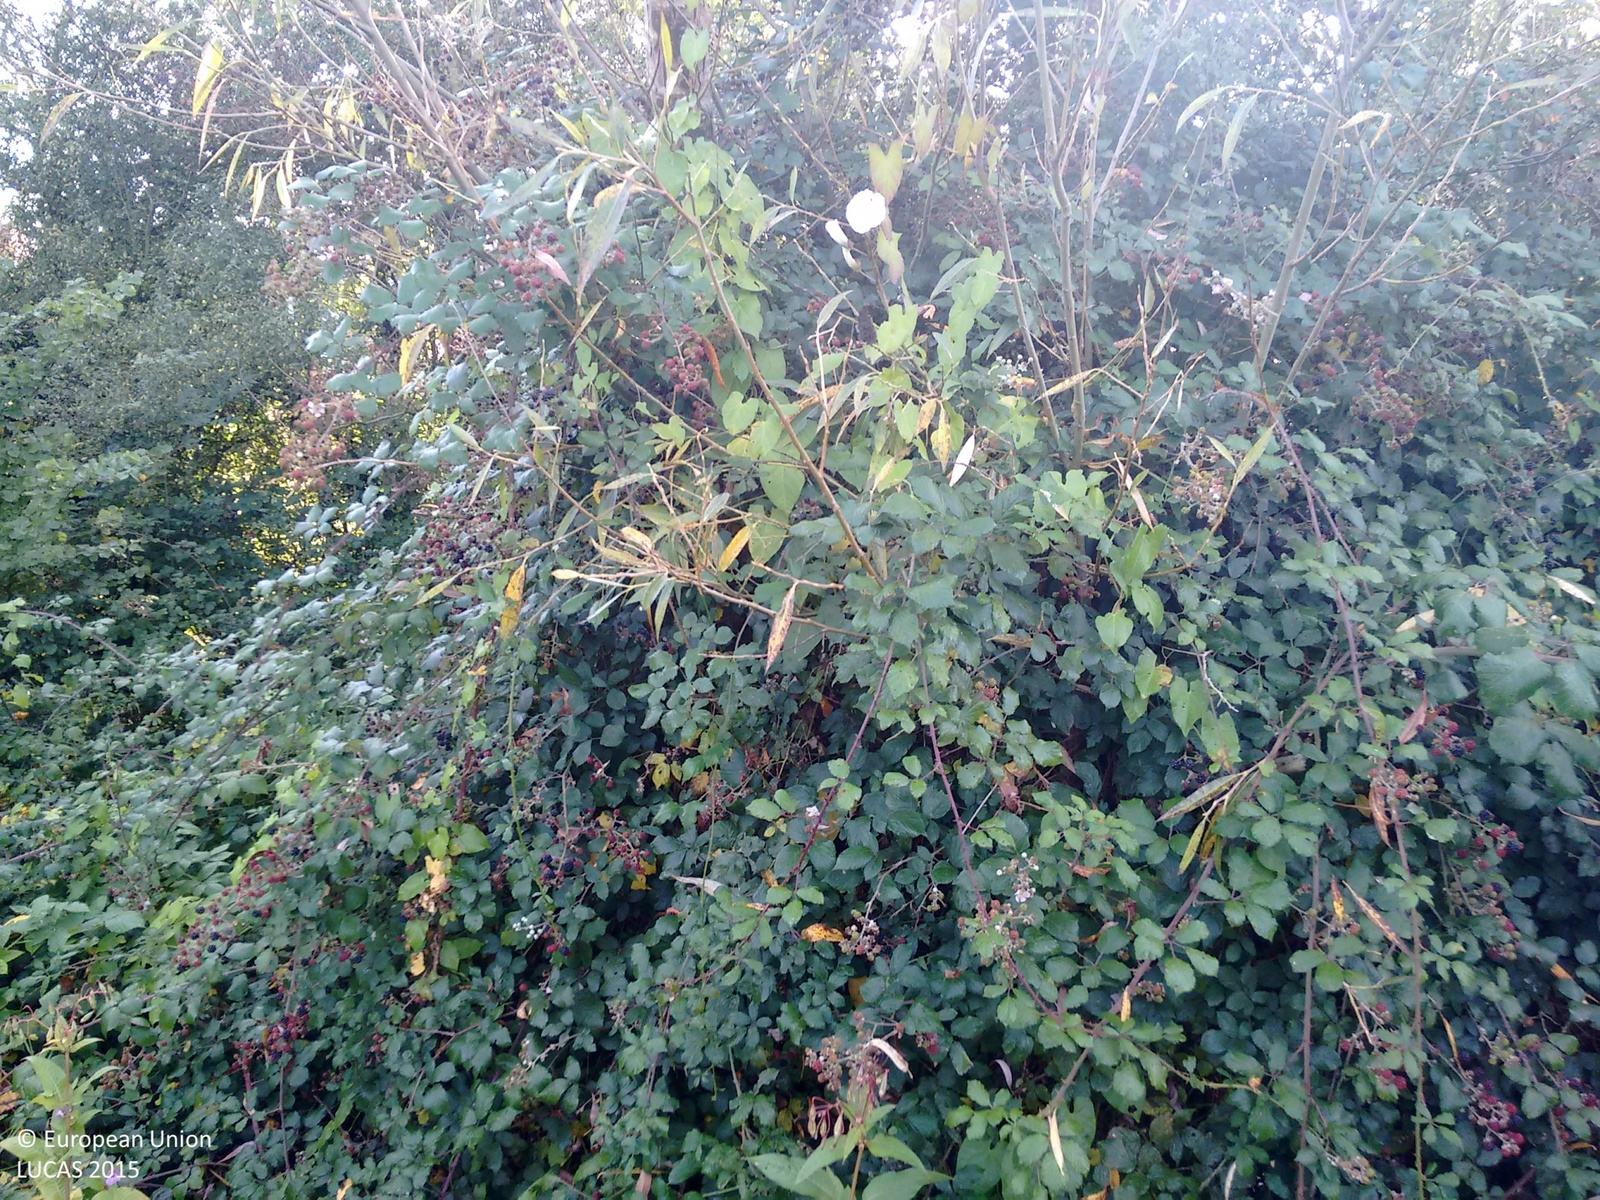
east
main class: Cropland
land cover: Arable land (only in case pi)
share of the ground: > 75 %
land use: Agriculture (excluding fallow land and kitchen gardens)
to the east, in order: Arable land (only in case pi); Electric lines; Arable land (only in case pi); Managed hedges; Maize
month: September
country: GB
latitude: 51.8797
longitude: -2.1323
